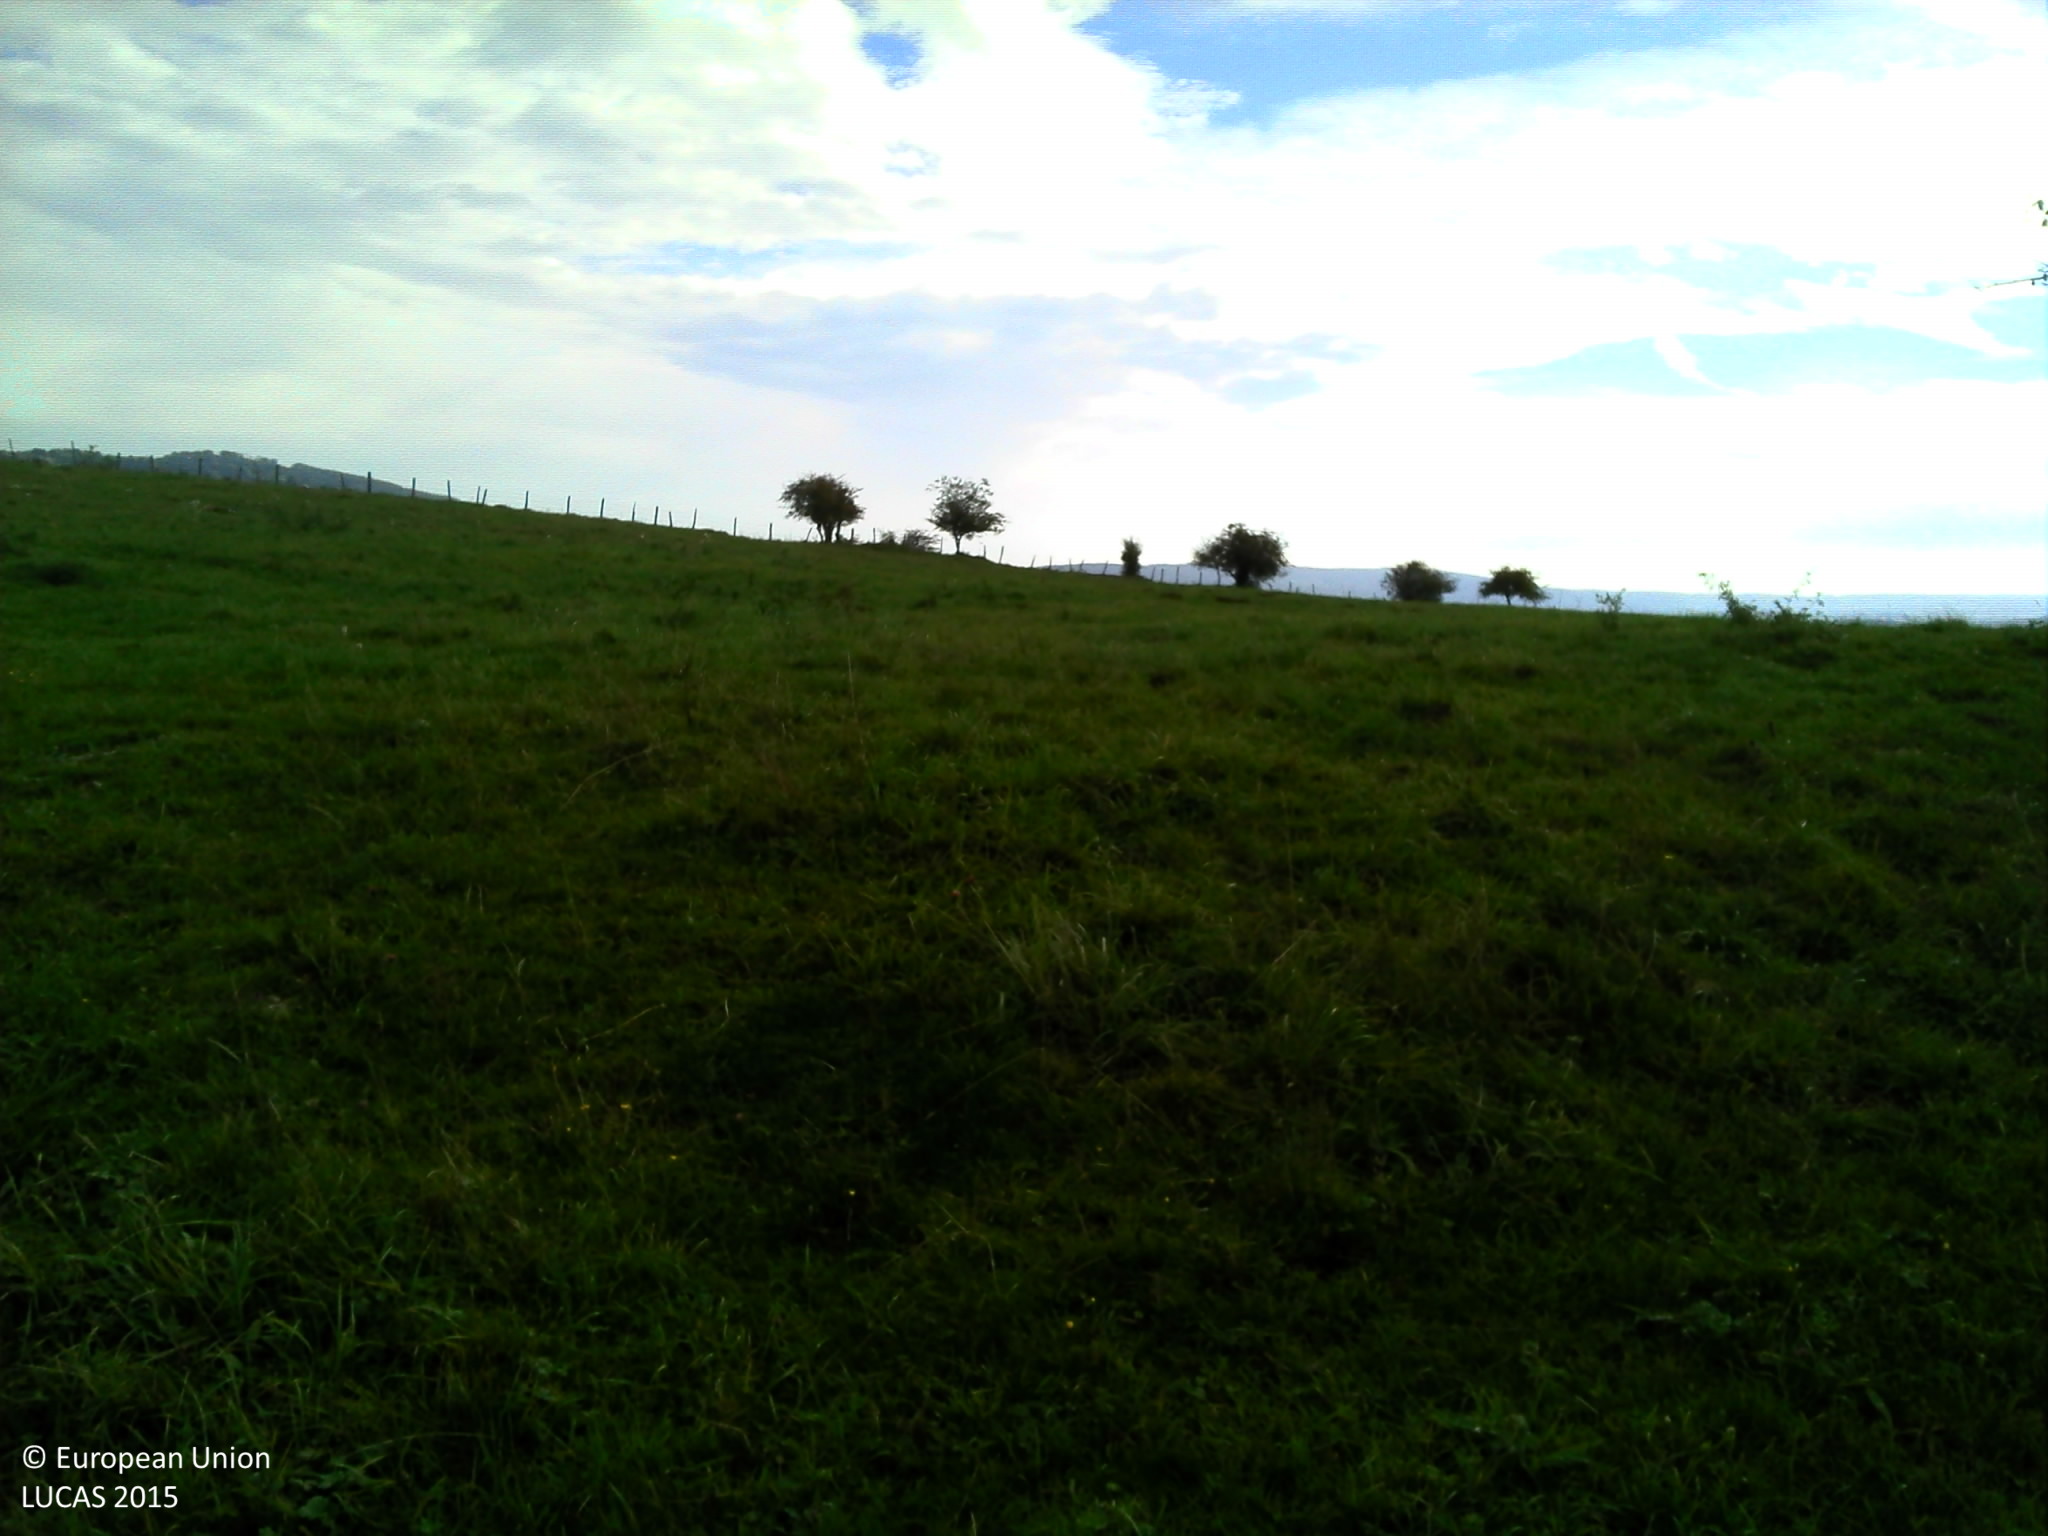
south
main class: Grassland
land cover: Grassland with sparse tree/shrub cover
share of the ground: > 75 %
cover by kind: herbaceous plants 95 %, broadleaved forest trees 5 %
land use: Agriculture (excluding fallow land and kitchen gardens)
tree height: > 5 m
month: October
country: FR
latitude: 47.0454
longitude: 6.3299
